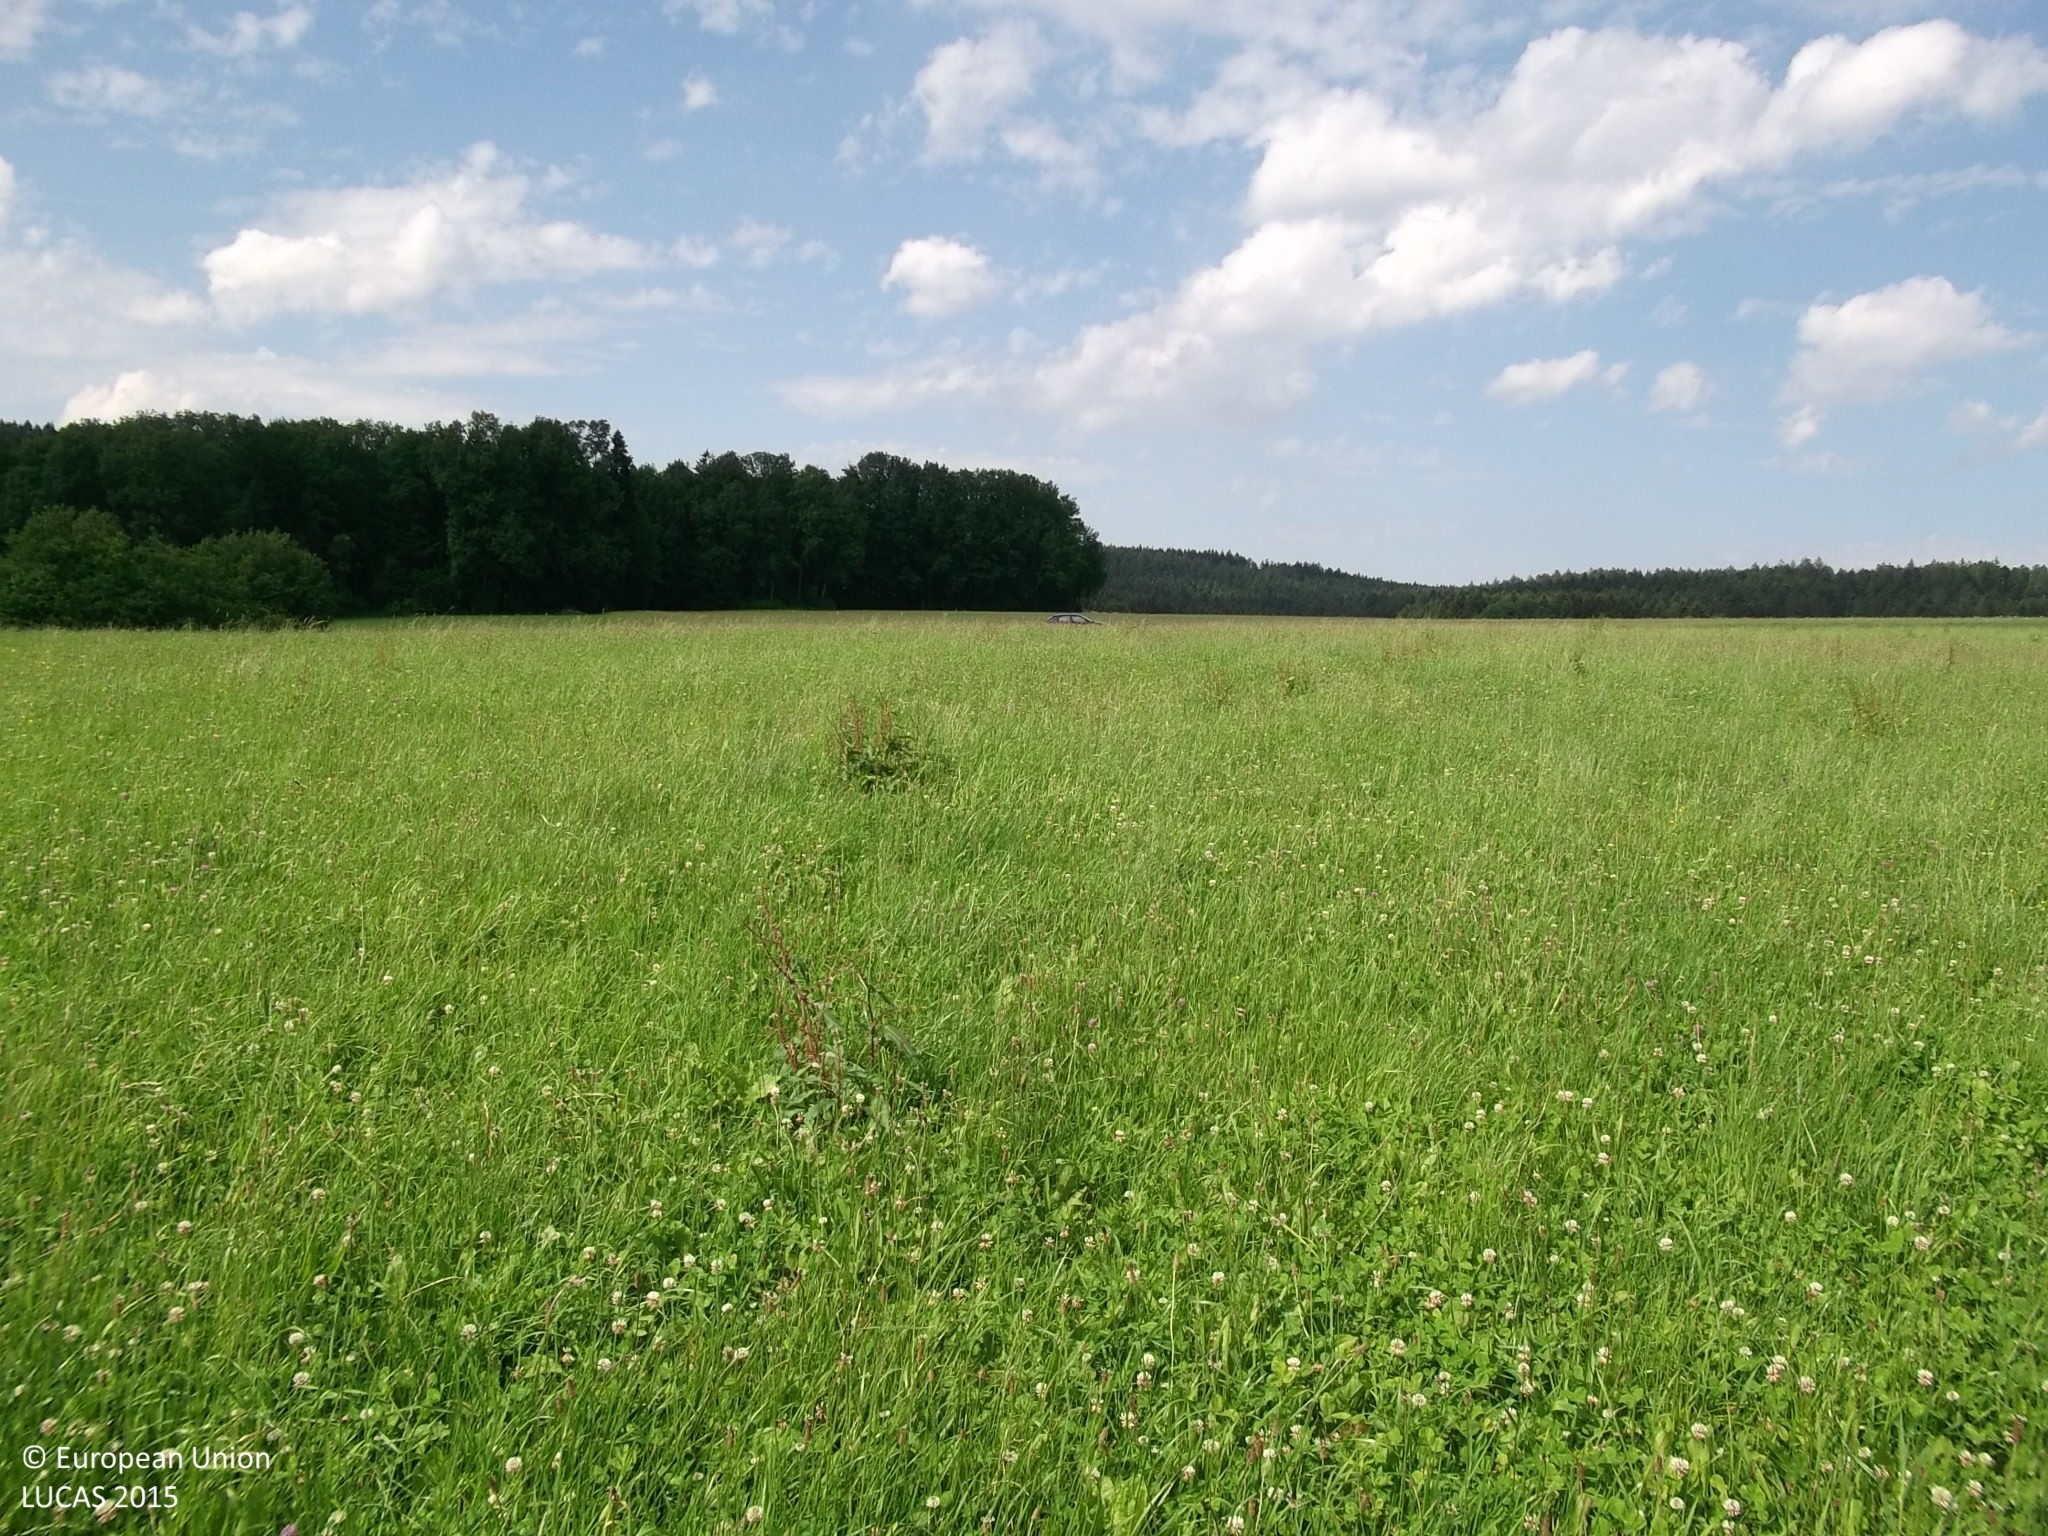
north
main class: Grassland
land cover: Grassland without tree/shrub cover
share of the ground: > 75 %
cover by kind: herbaceous plants 100 %
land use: Agriculture (excluding fallow land and kitchen gardens)
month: June
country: AT
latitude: 48.0110
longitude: 13.3369
